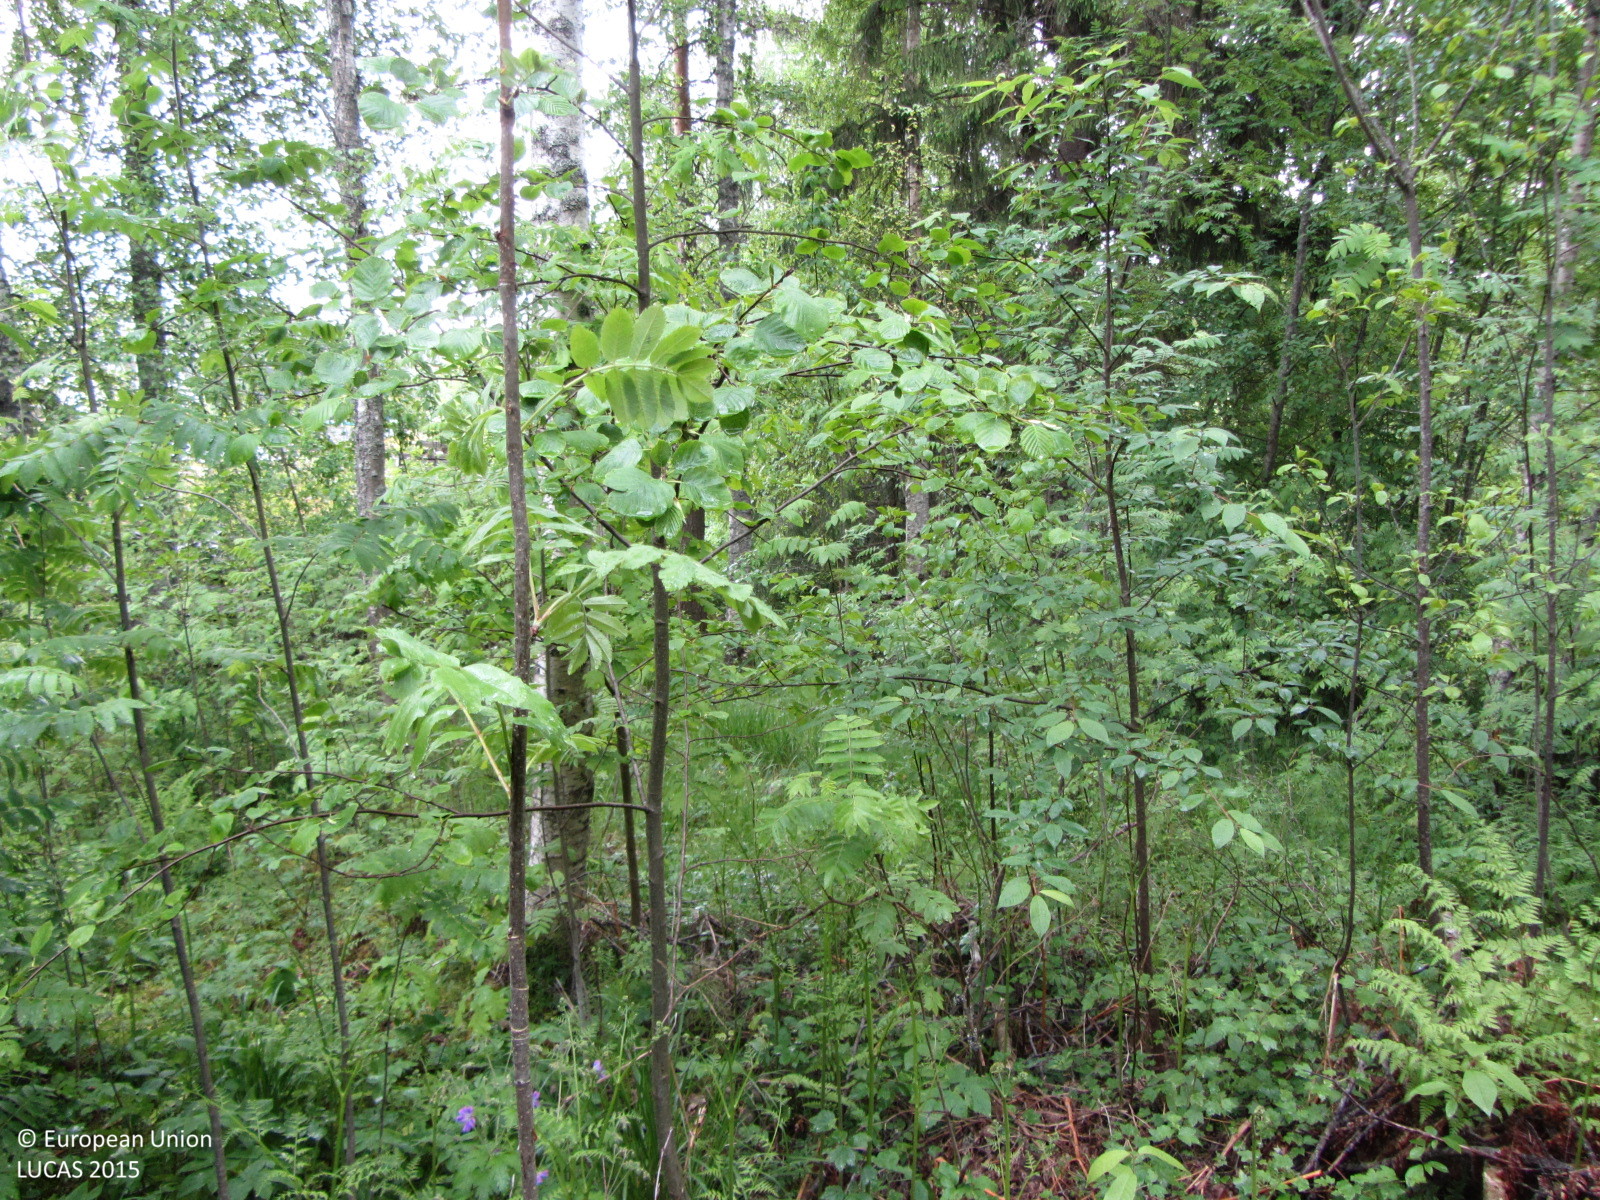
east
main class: Woodland
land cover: Other mixed woodland
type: boreal forest
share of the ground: 50 - 75 %
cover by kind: broadleaved forest trees 40 %, herbaceous plants 35 %, coniferous forest trees 25 %
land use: Forestry
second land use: Residential
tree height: > 5 m
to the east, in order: Other mixed woodland; Ditches and canals; Other mixed woodland; Electric lines; Spontaneously vegetated surfaces; Ditches and canals; Paved roads, cycling and walking lanes; Ditches and canals; Common wheat; Ditches and canals; Paved roads, cycling and walking lanes; Ditches and canals; Oats
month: June
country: FI
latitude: 60.4327
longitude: 24.7000
